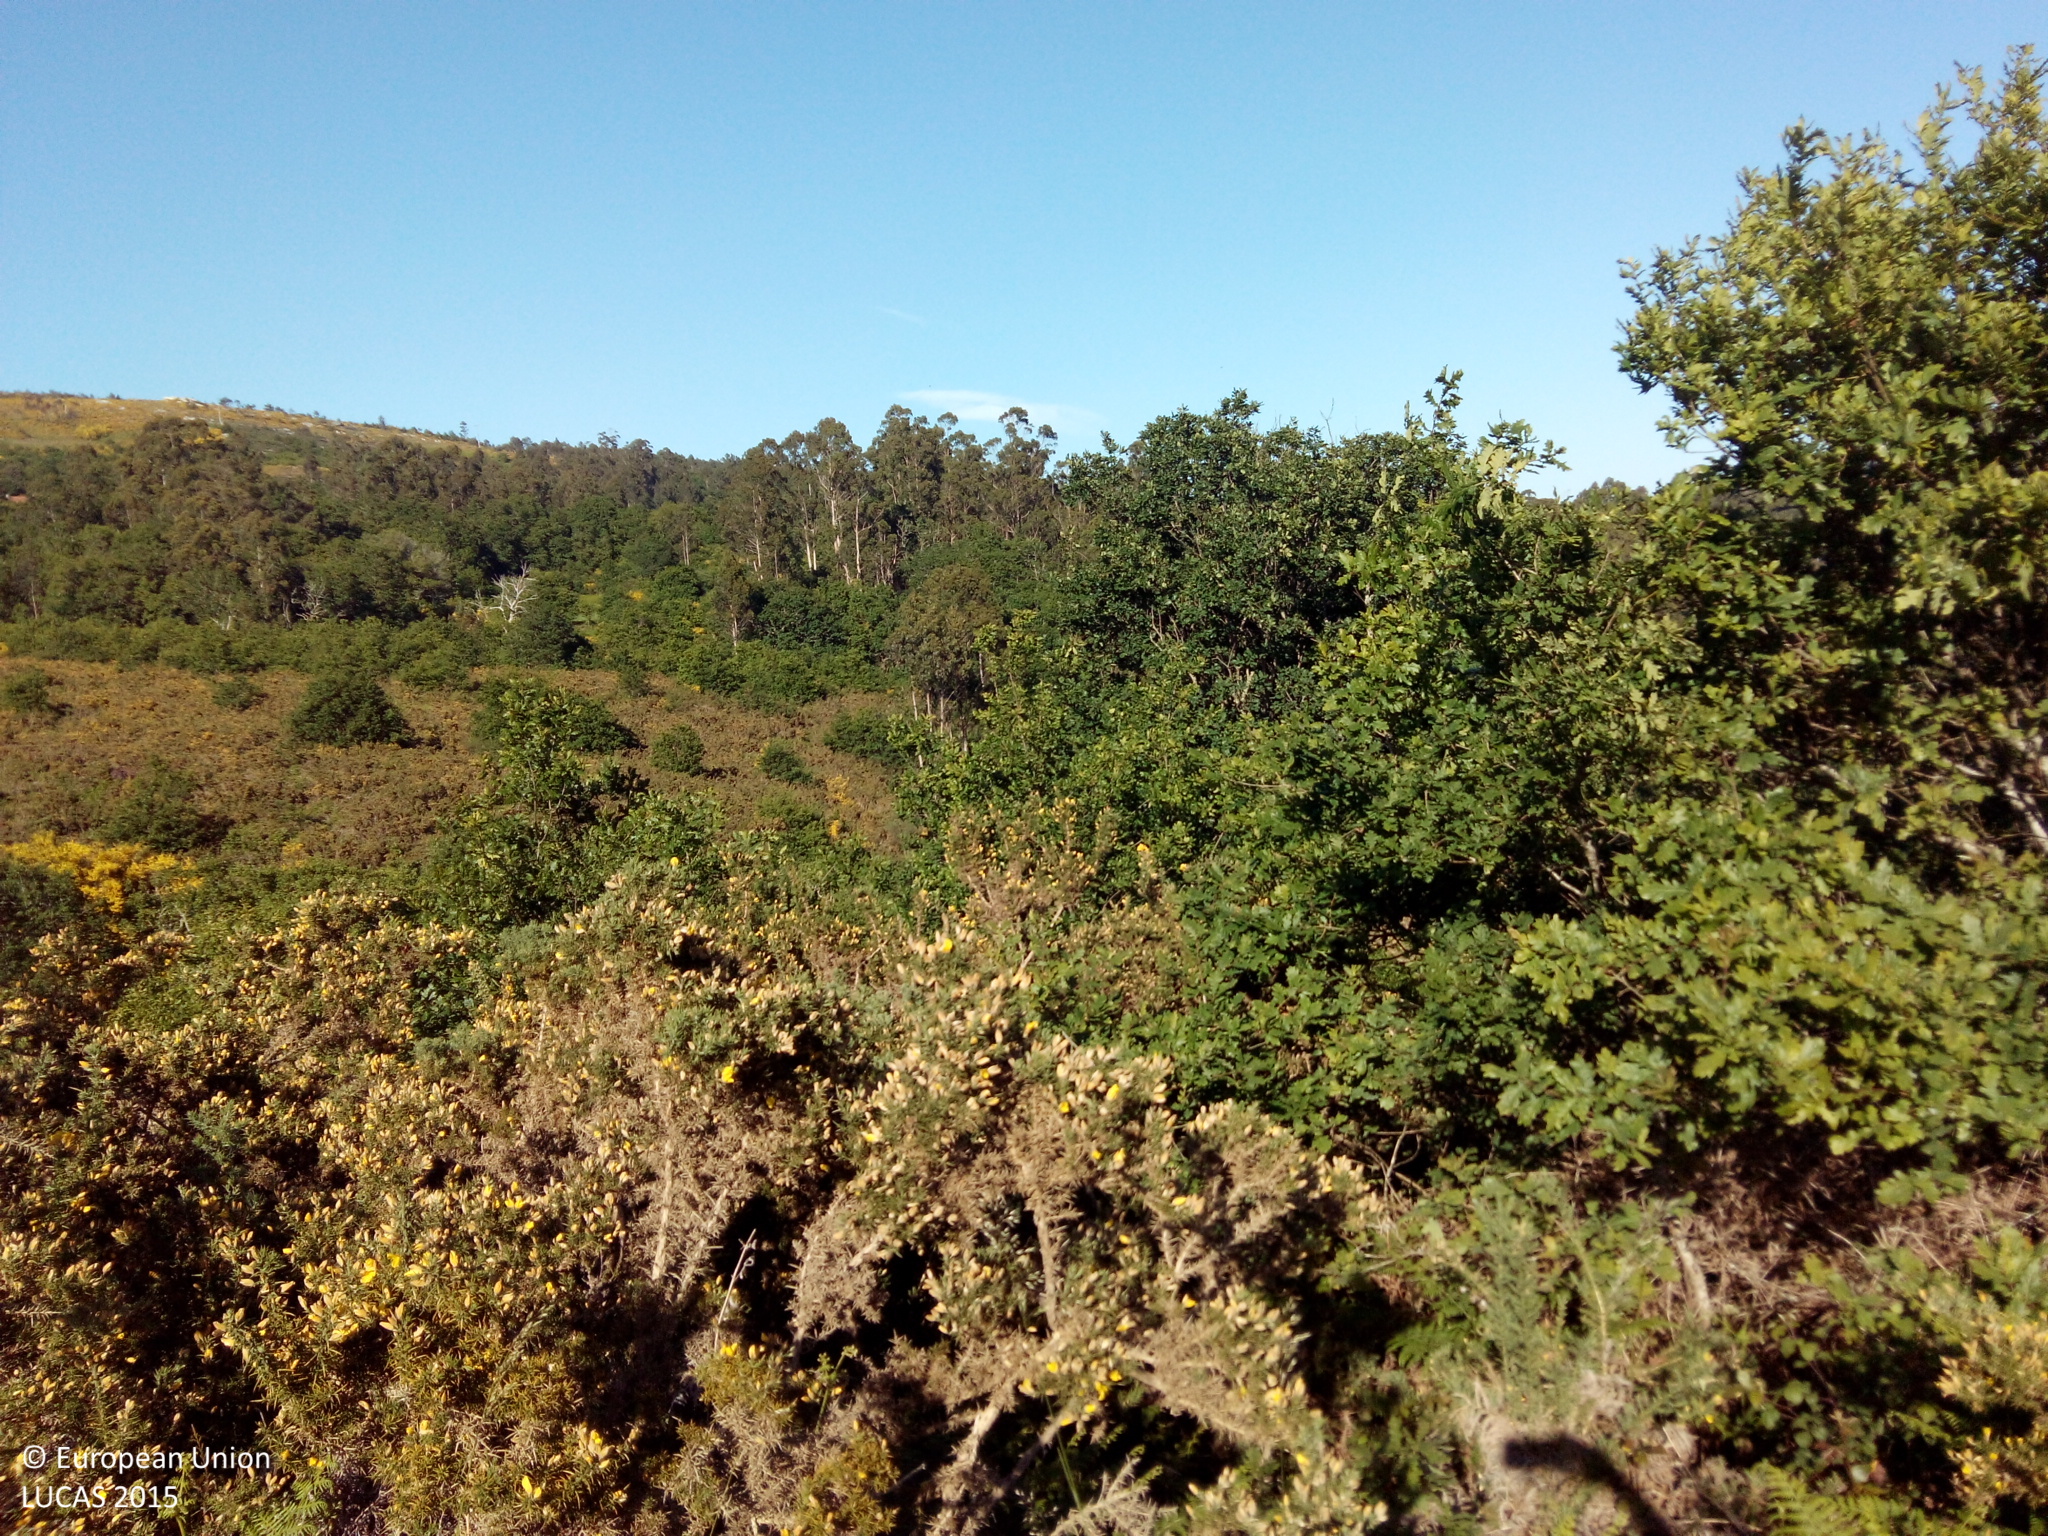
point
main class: Woodland
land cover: Broadleaved woodland
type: acidophilous oak and oak-birch forest
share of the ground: > 75 %
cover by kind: broadleaved forest trees 100 %
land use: Forestry
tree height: > 5 m
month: May
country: ES
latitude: 42.5360
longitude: -8.4204
